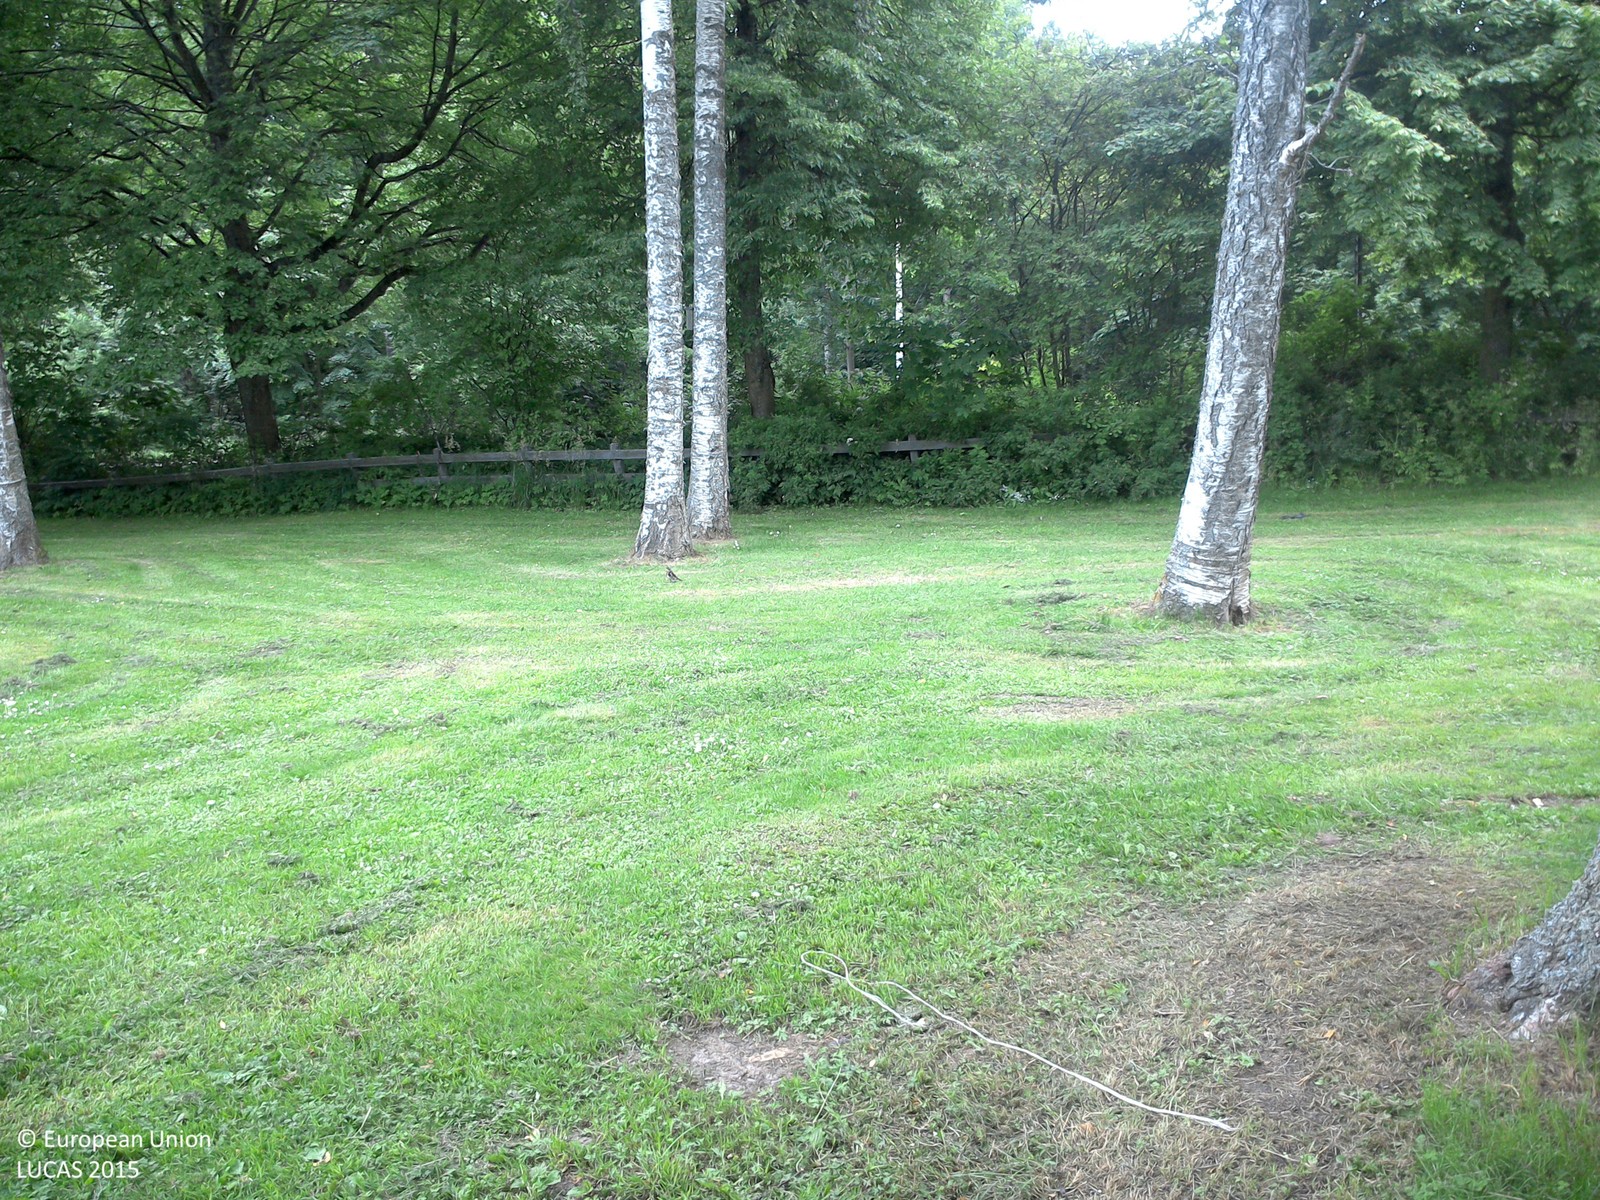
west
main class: Woodland
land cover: Broadleaved woodland
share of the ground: < 10 %
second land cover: Grassland without tree/shrub cover
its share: > 75 %
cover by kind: herbaceous plants 75 %, broadleaved forest trees 25 %
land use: Amenities, museums, leisure
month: June
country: SE
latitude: 58.4113
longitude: 15.5572
